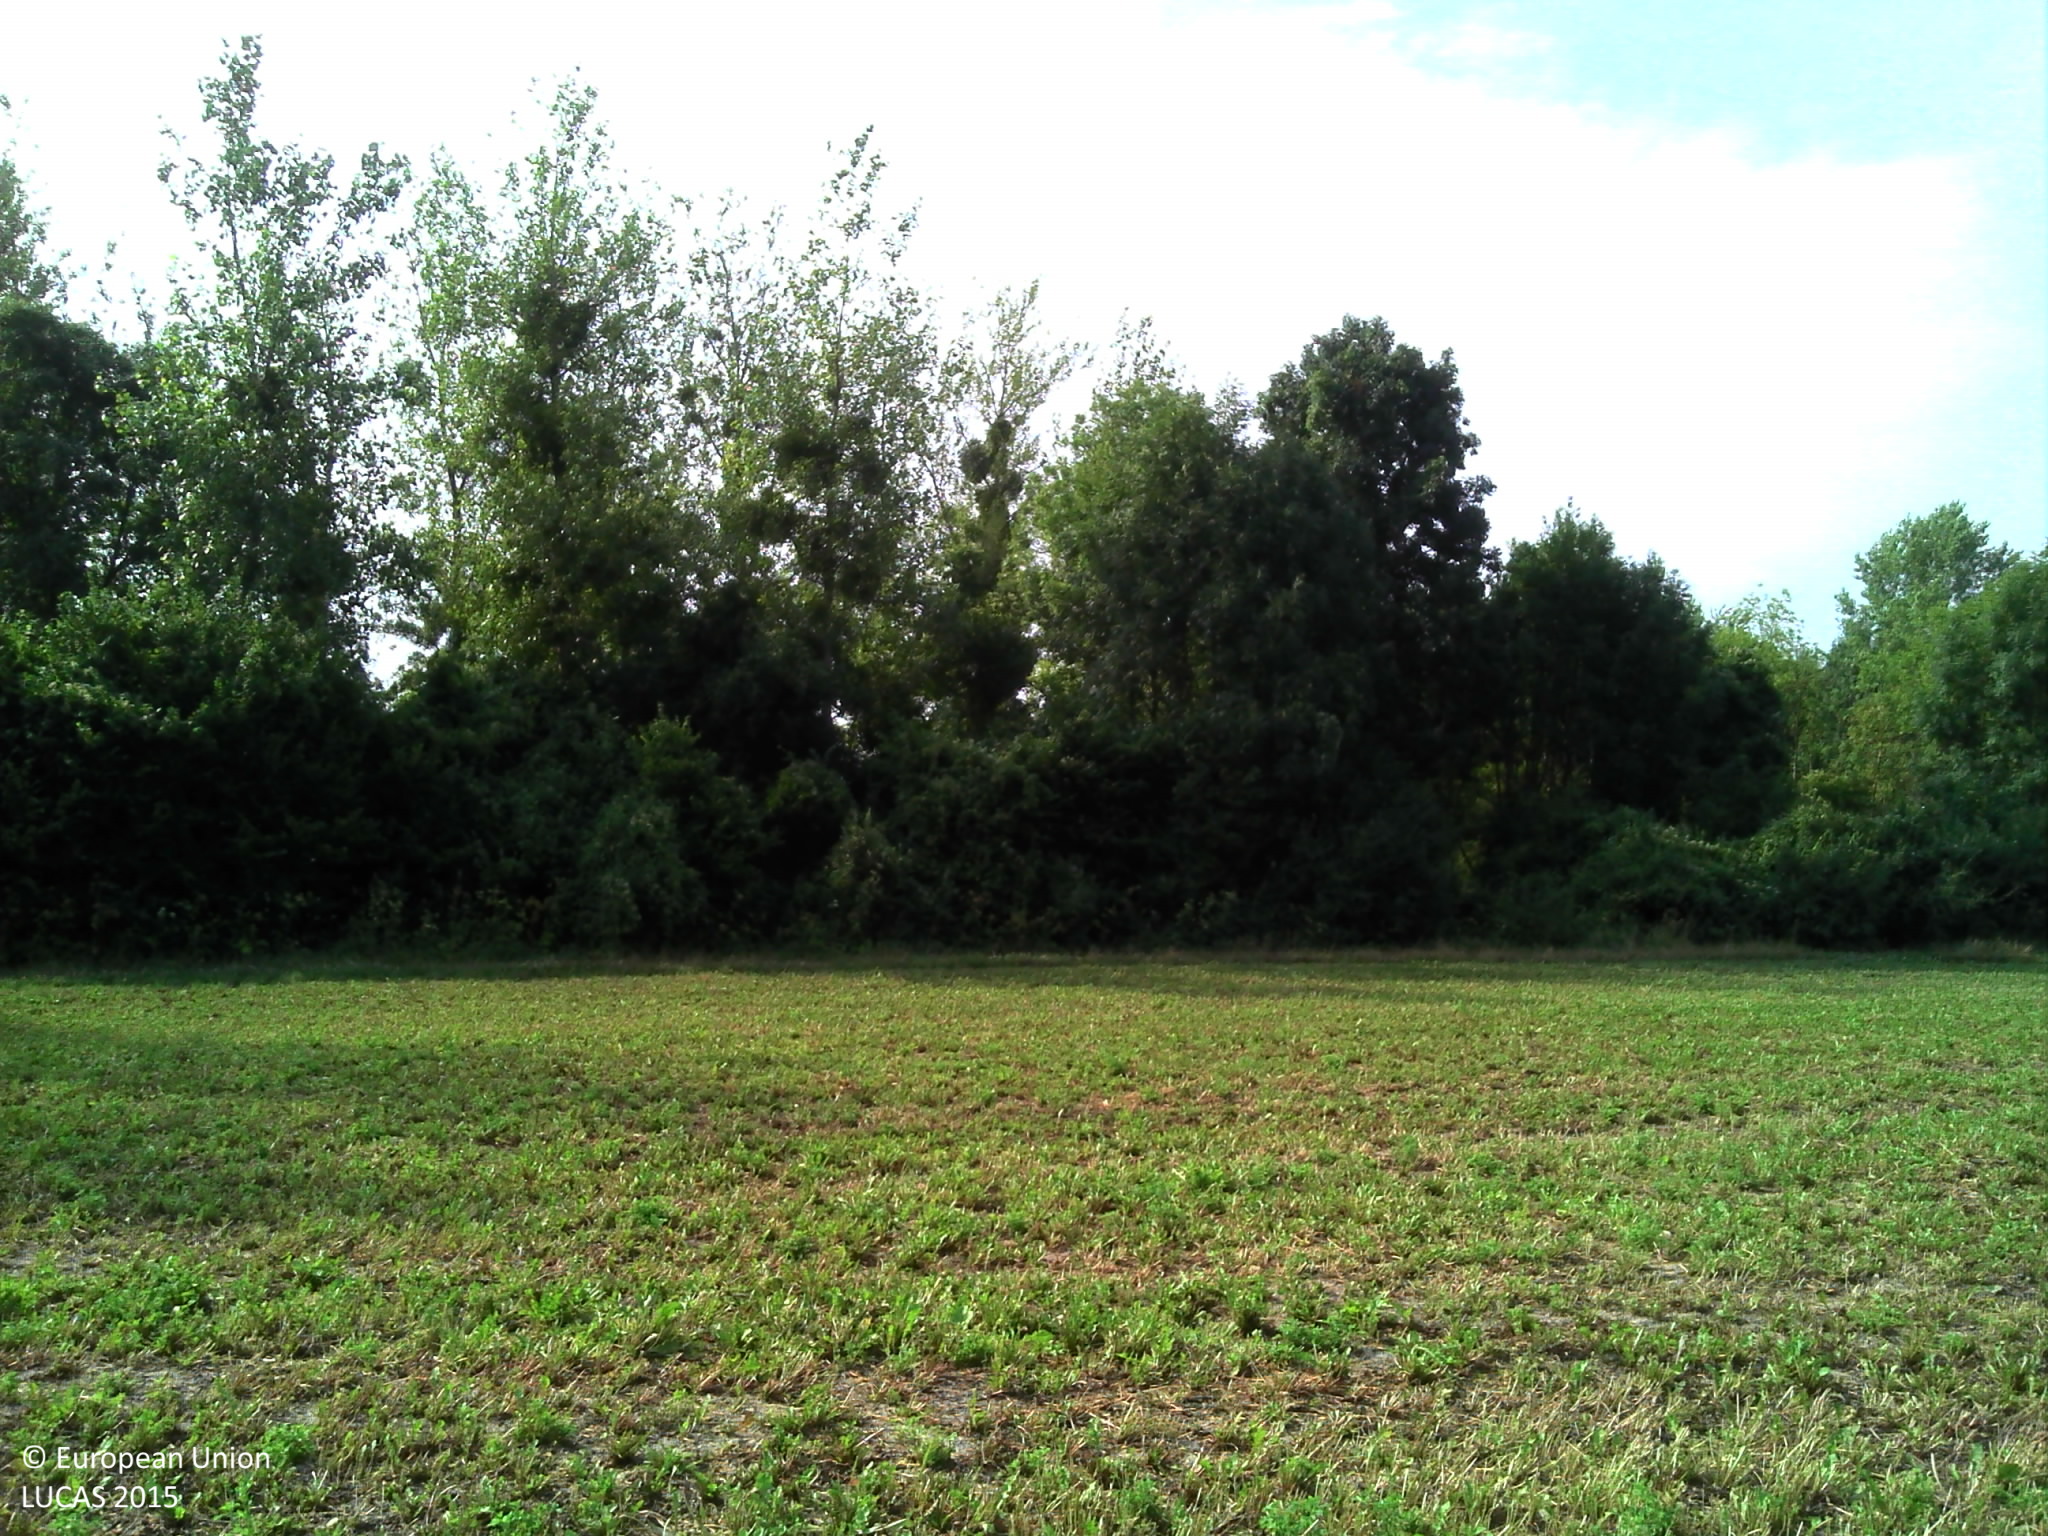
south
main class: Cropland
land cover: Temporary grasslands
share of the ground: > 75 %
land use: Agriculture (excluding fallow land and kitchen gardens)
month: August
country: FR
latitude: 48.6979
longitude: 3.7856
